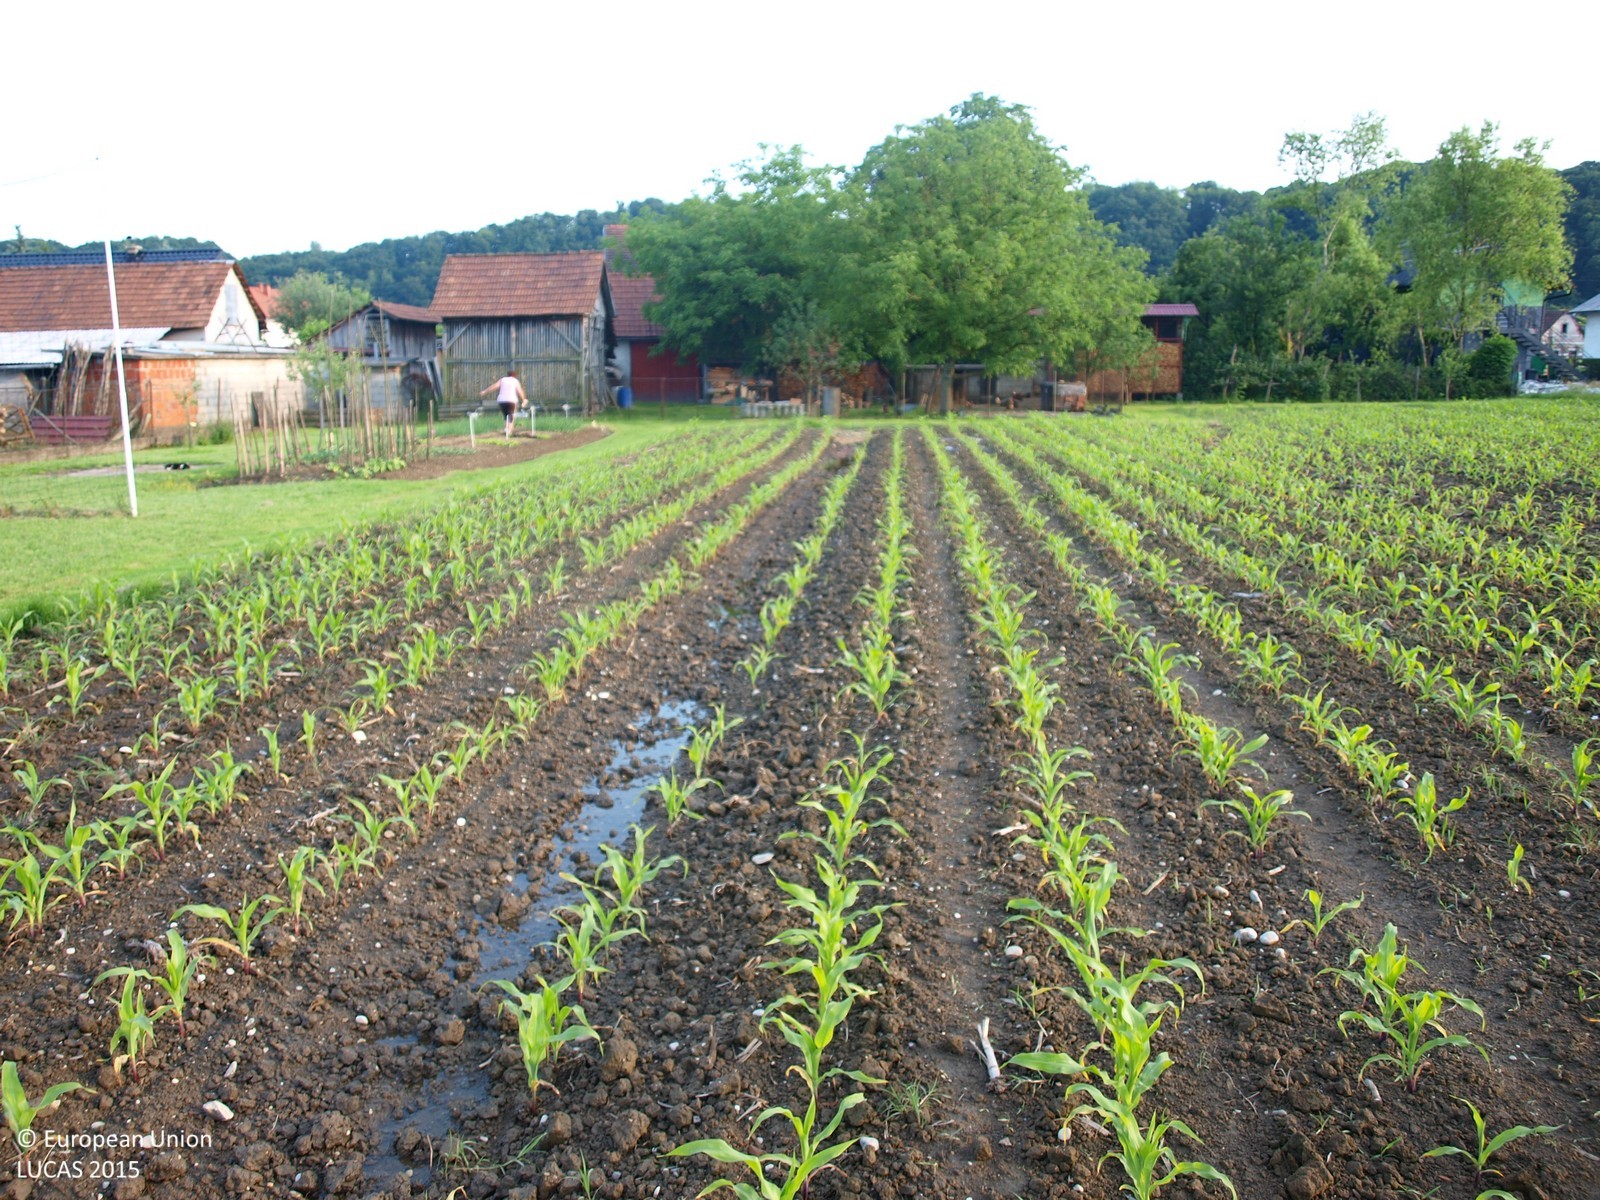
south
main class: Cropland
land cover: Maize
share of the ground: 10 - 25 %
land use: Agriculture (excluding fallow land and kitchen gardens)
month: June
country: HR
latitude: 46.3759
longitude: 16.0970
